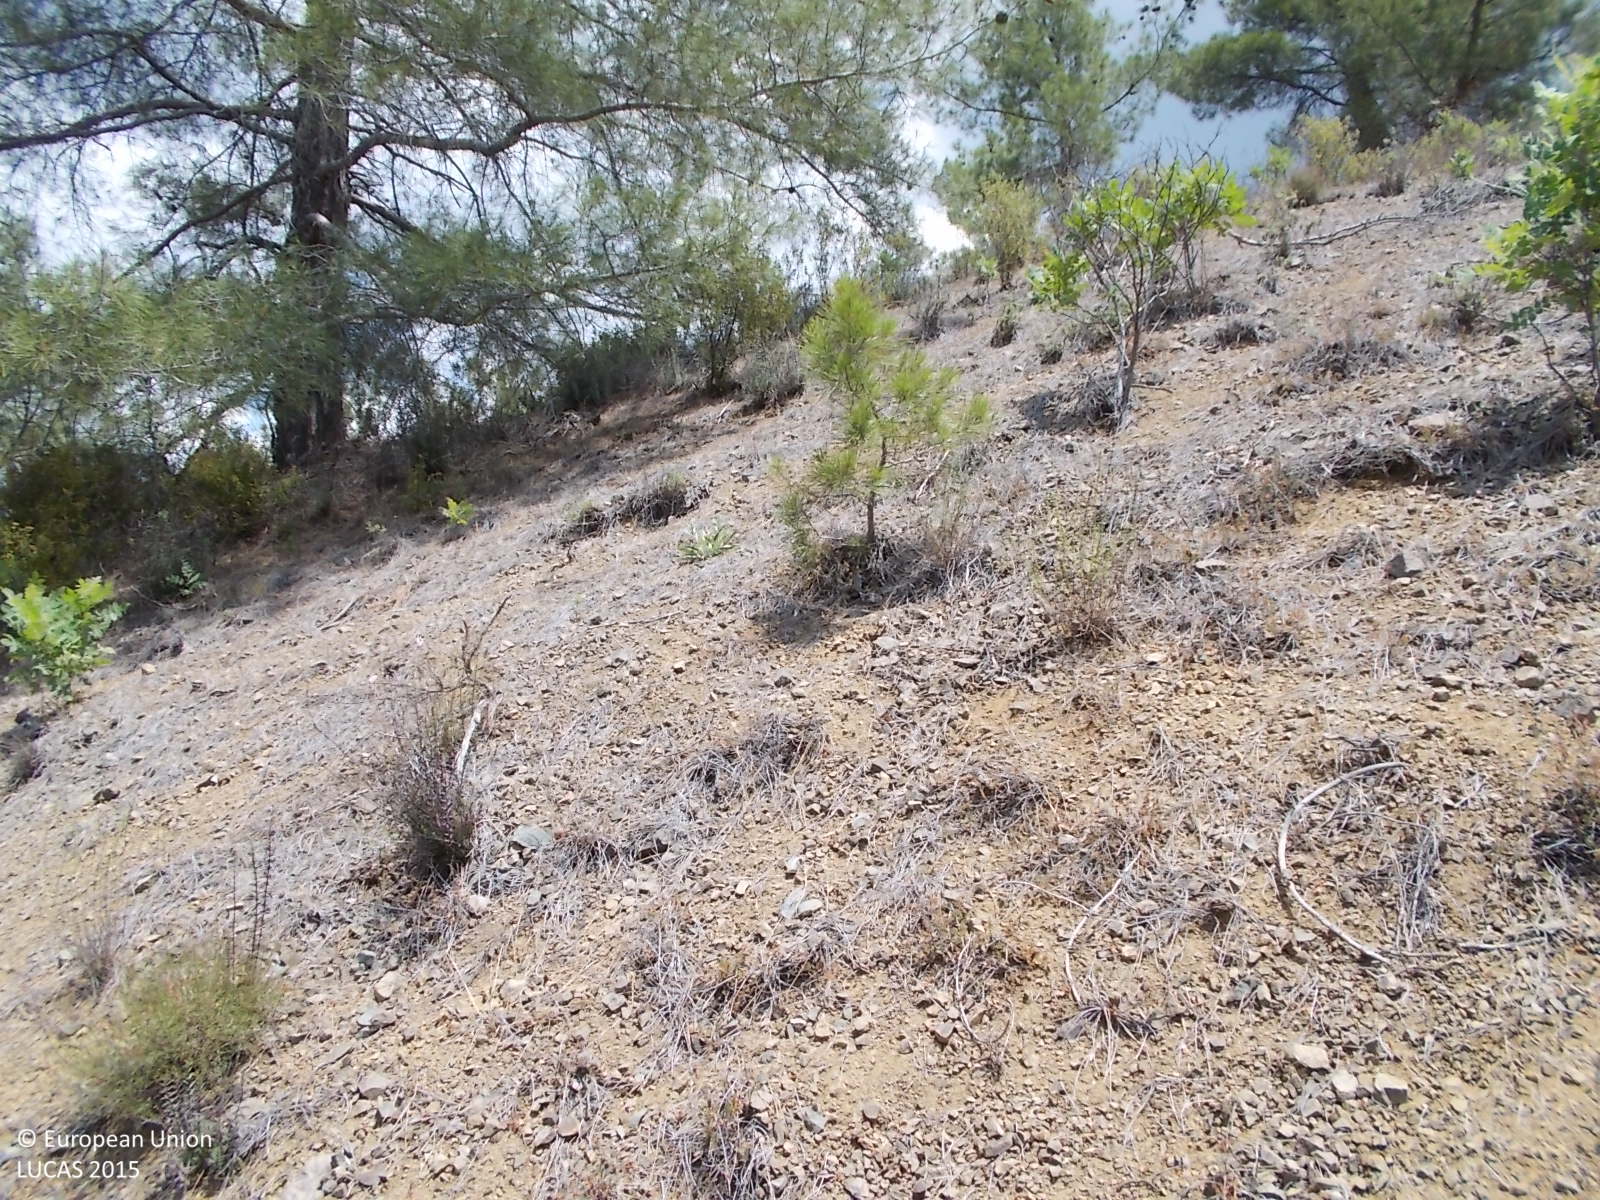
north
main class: Woodland
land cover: Pine dominated coniferous woodland
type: coniferous forest of the mediterranean region
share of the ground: 25 - 50 %
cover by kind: coniferous forest trees 40 %, unconsolidated bare surface 40 %, shrubs 20 %
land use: Forestry
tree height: > 5 m
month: June
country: CY
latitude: 34.8772
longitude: 32.8205
